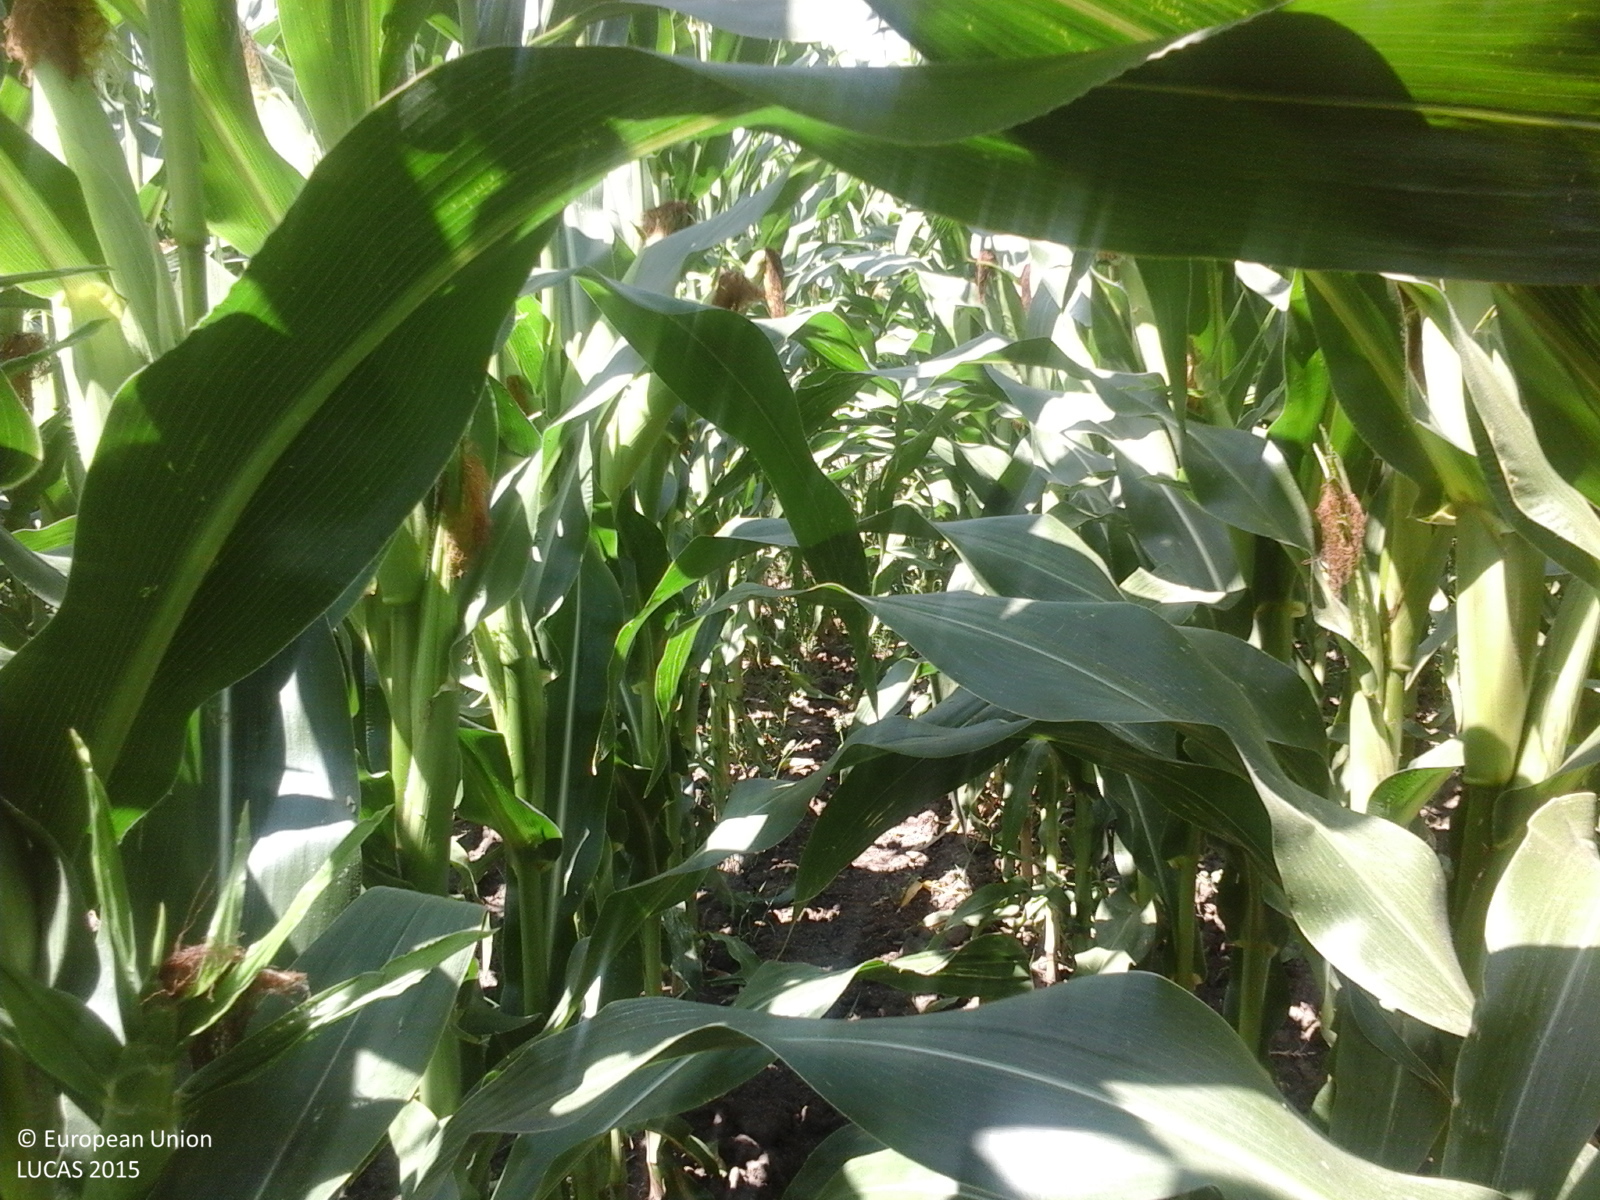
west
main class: Cropland
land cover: Maize
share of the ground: > 75 %
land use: Agriculture (excluding fallow land and kitchen gardens)
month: July
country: RO
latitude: 44.5188
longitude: 27.1037
